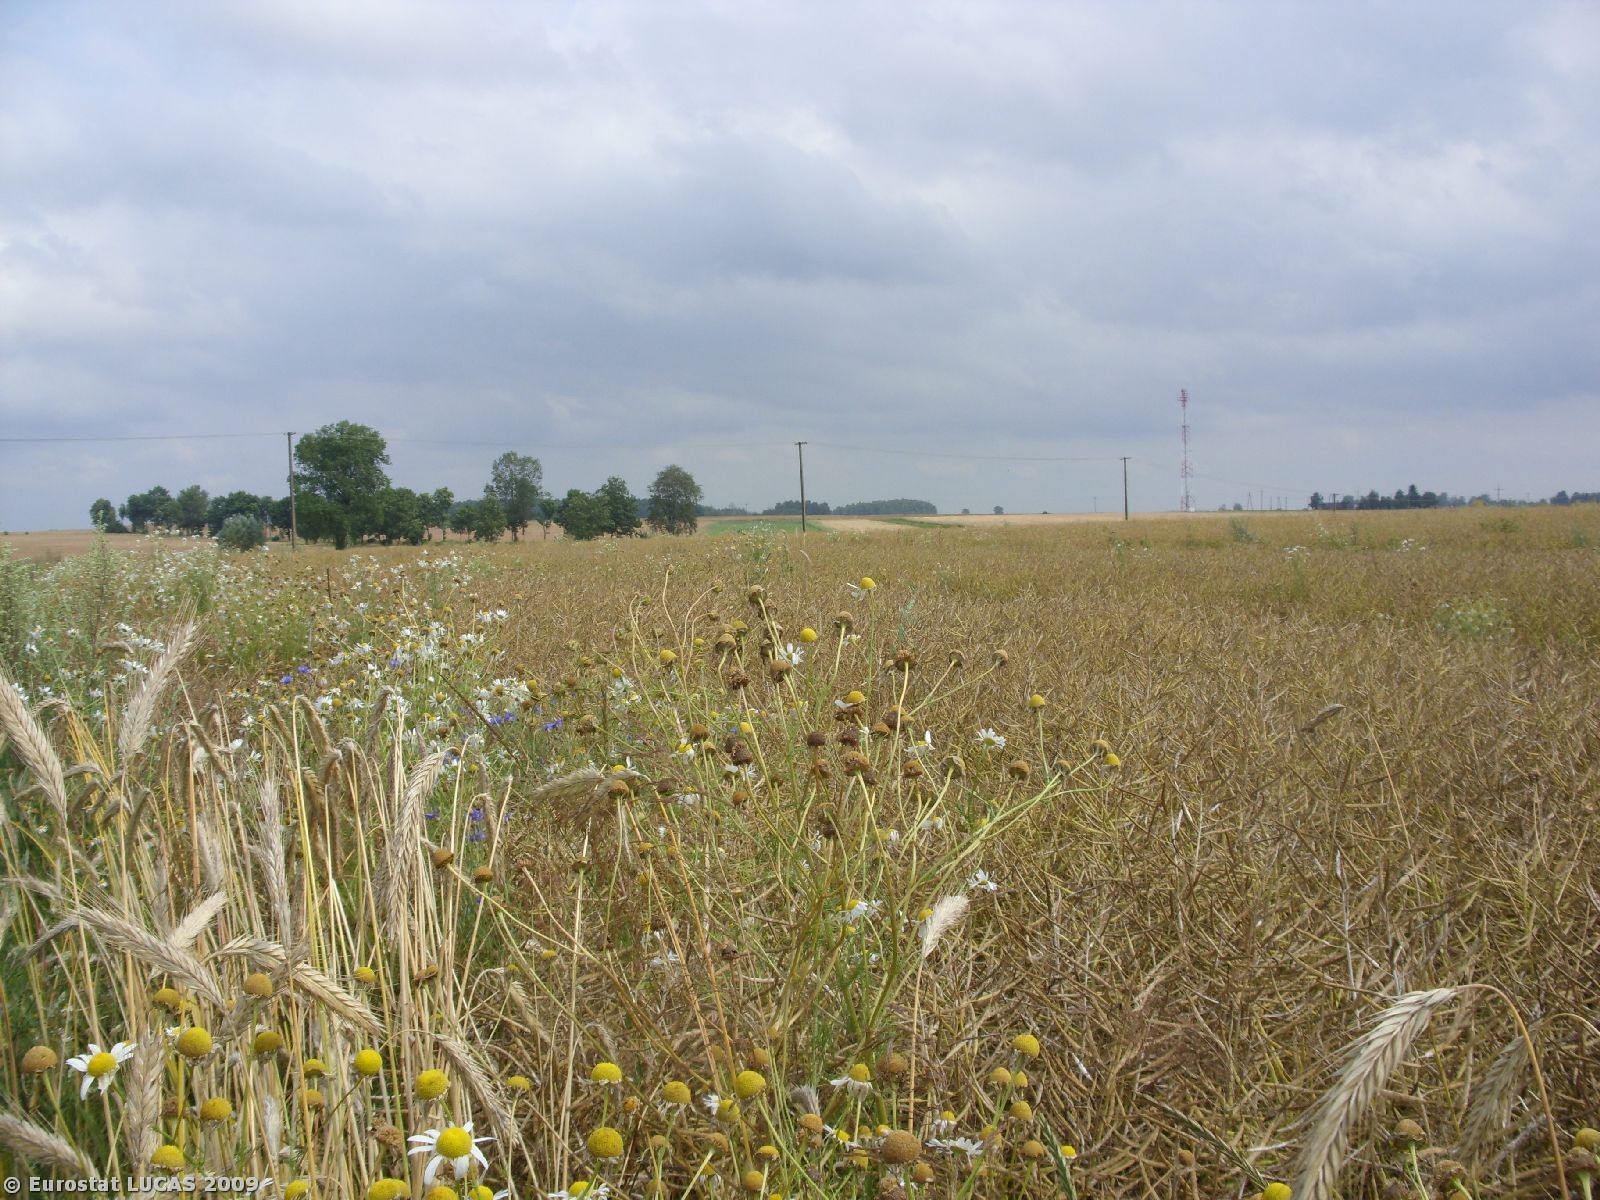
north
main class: Cropland
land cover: Rape and turnip rape
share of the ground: > 75 %
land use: Agriculture (excluding fallow land and kitchen gardens)
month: July
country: PL
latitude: 54.0331
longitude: 15.5146
